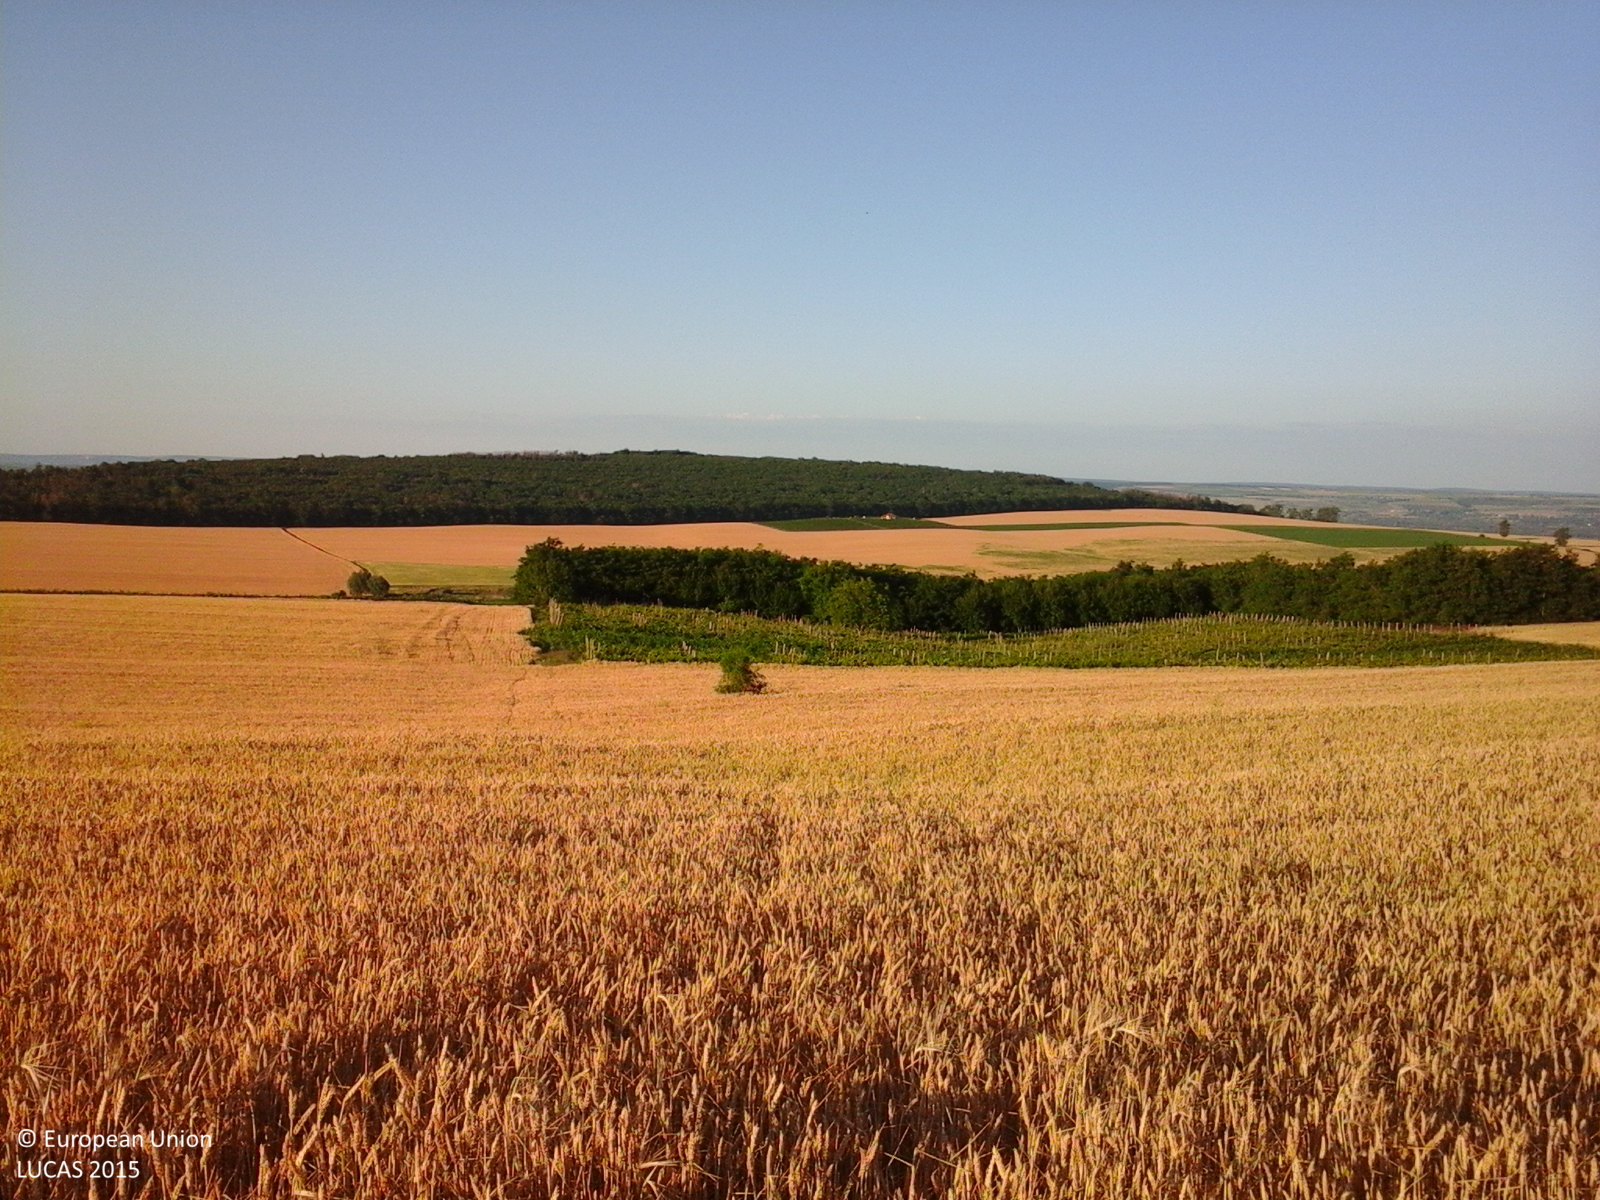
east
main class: Cropland
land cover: Common wheat
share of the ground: > 75 %
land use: Agriculture (excluding fallow land and kitchen gardens)
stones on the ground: < 10 %
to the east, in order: Common wheat; Vineyards; Maize; Common wheat; Broadleaved woodland
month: June
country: RO
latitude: 46.9664
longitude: 27.9911
